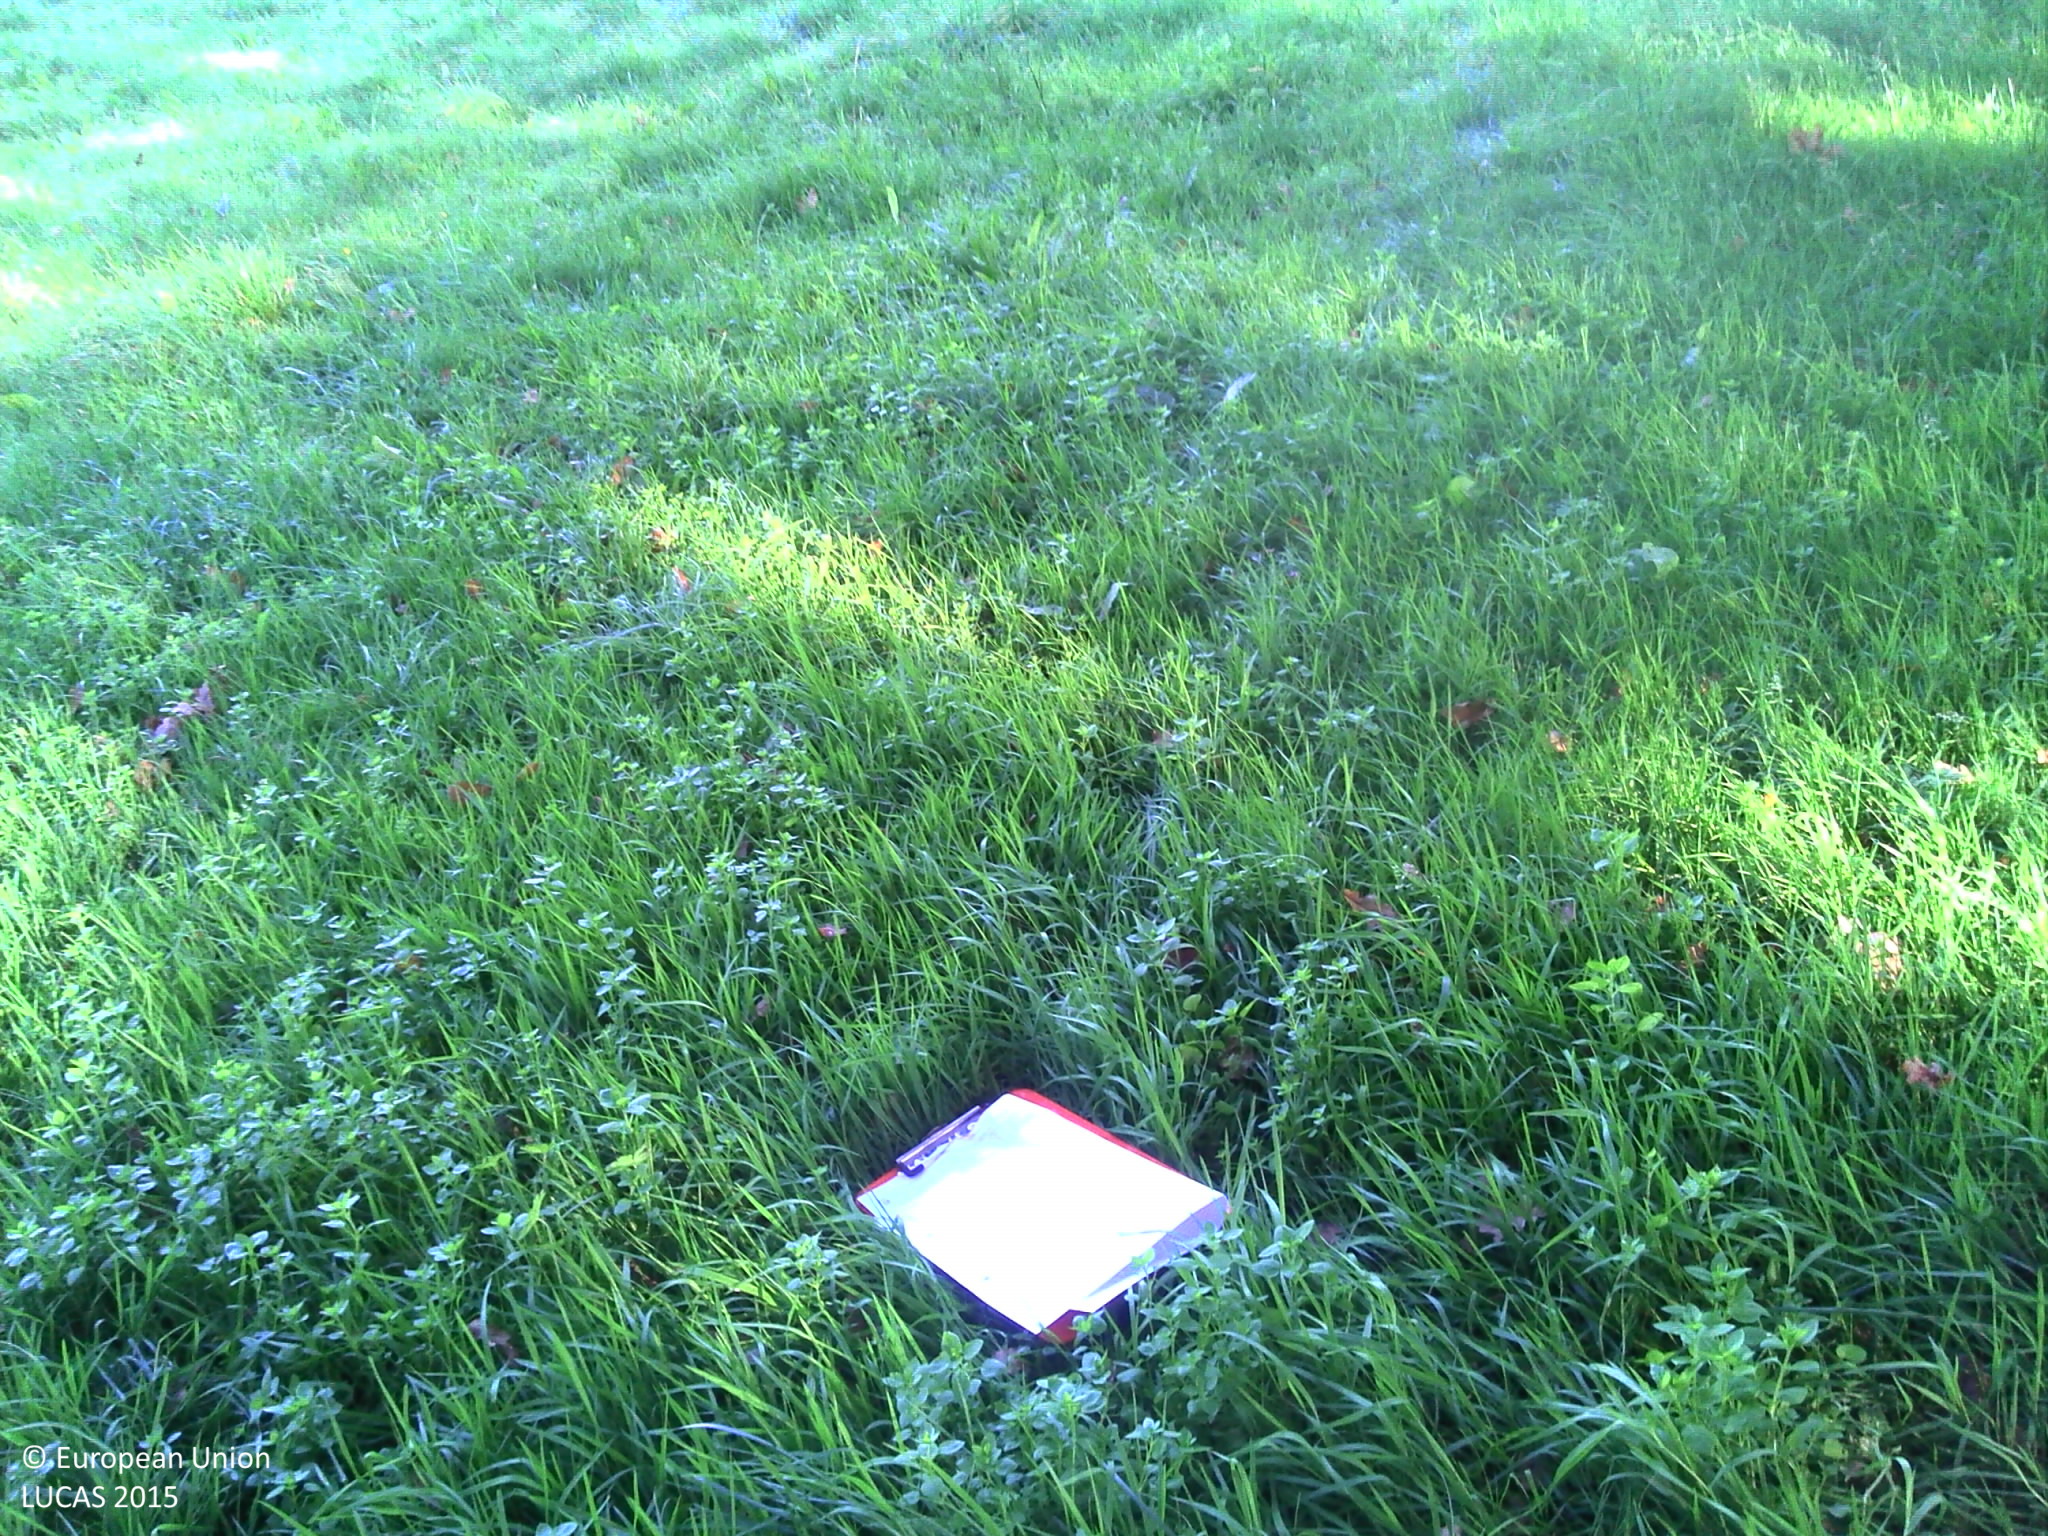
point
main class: Grassland
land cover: Grassland without tree/shrub cover
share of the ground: > 75 %
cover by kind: herbaceous plants 100 %
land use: Agriculture (excluding fallow land and kitchen gardens)
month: October
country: FR
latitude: 47.5685
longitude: -2.1347
